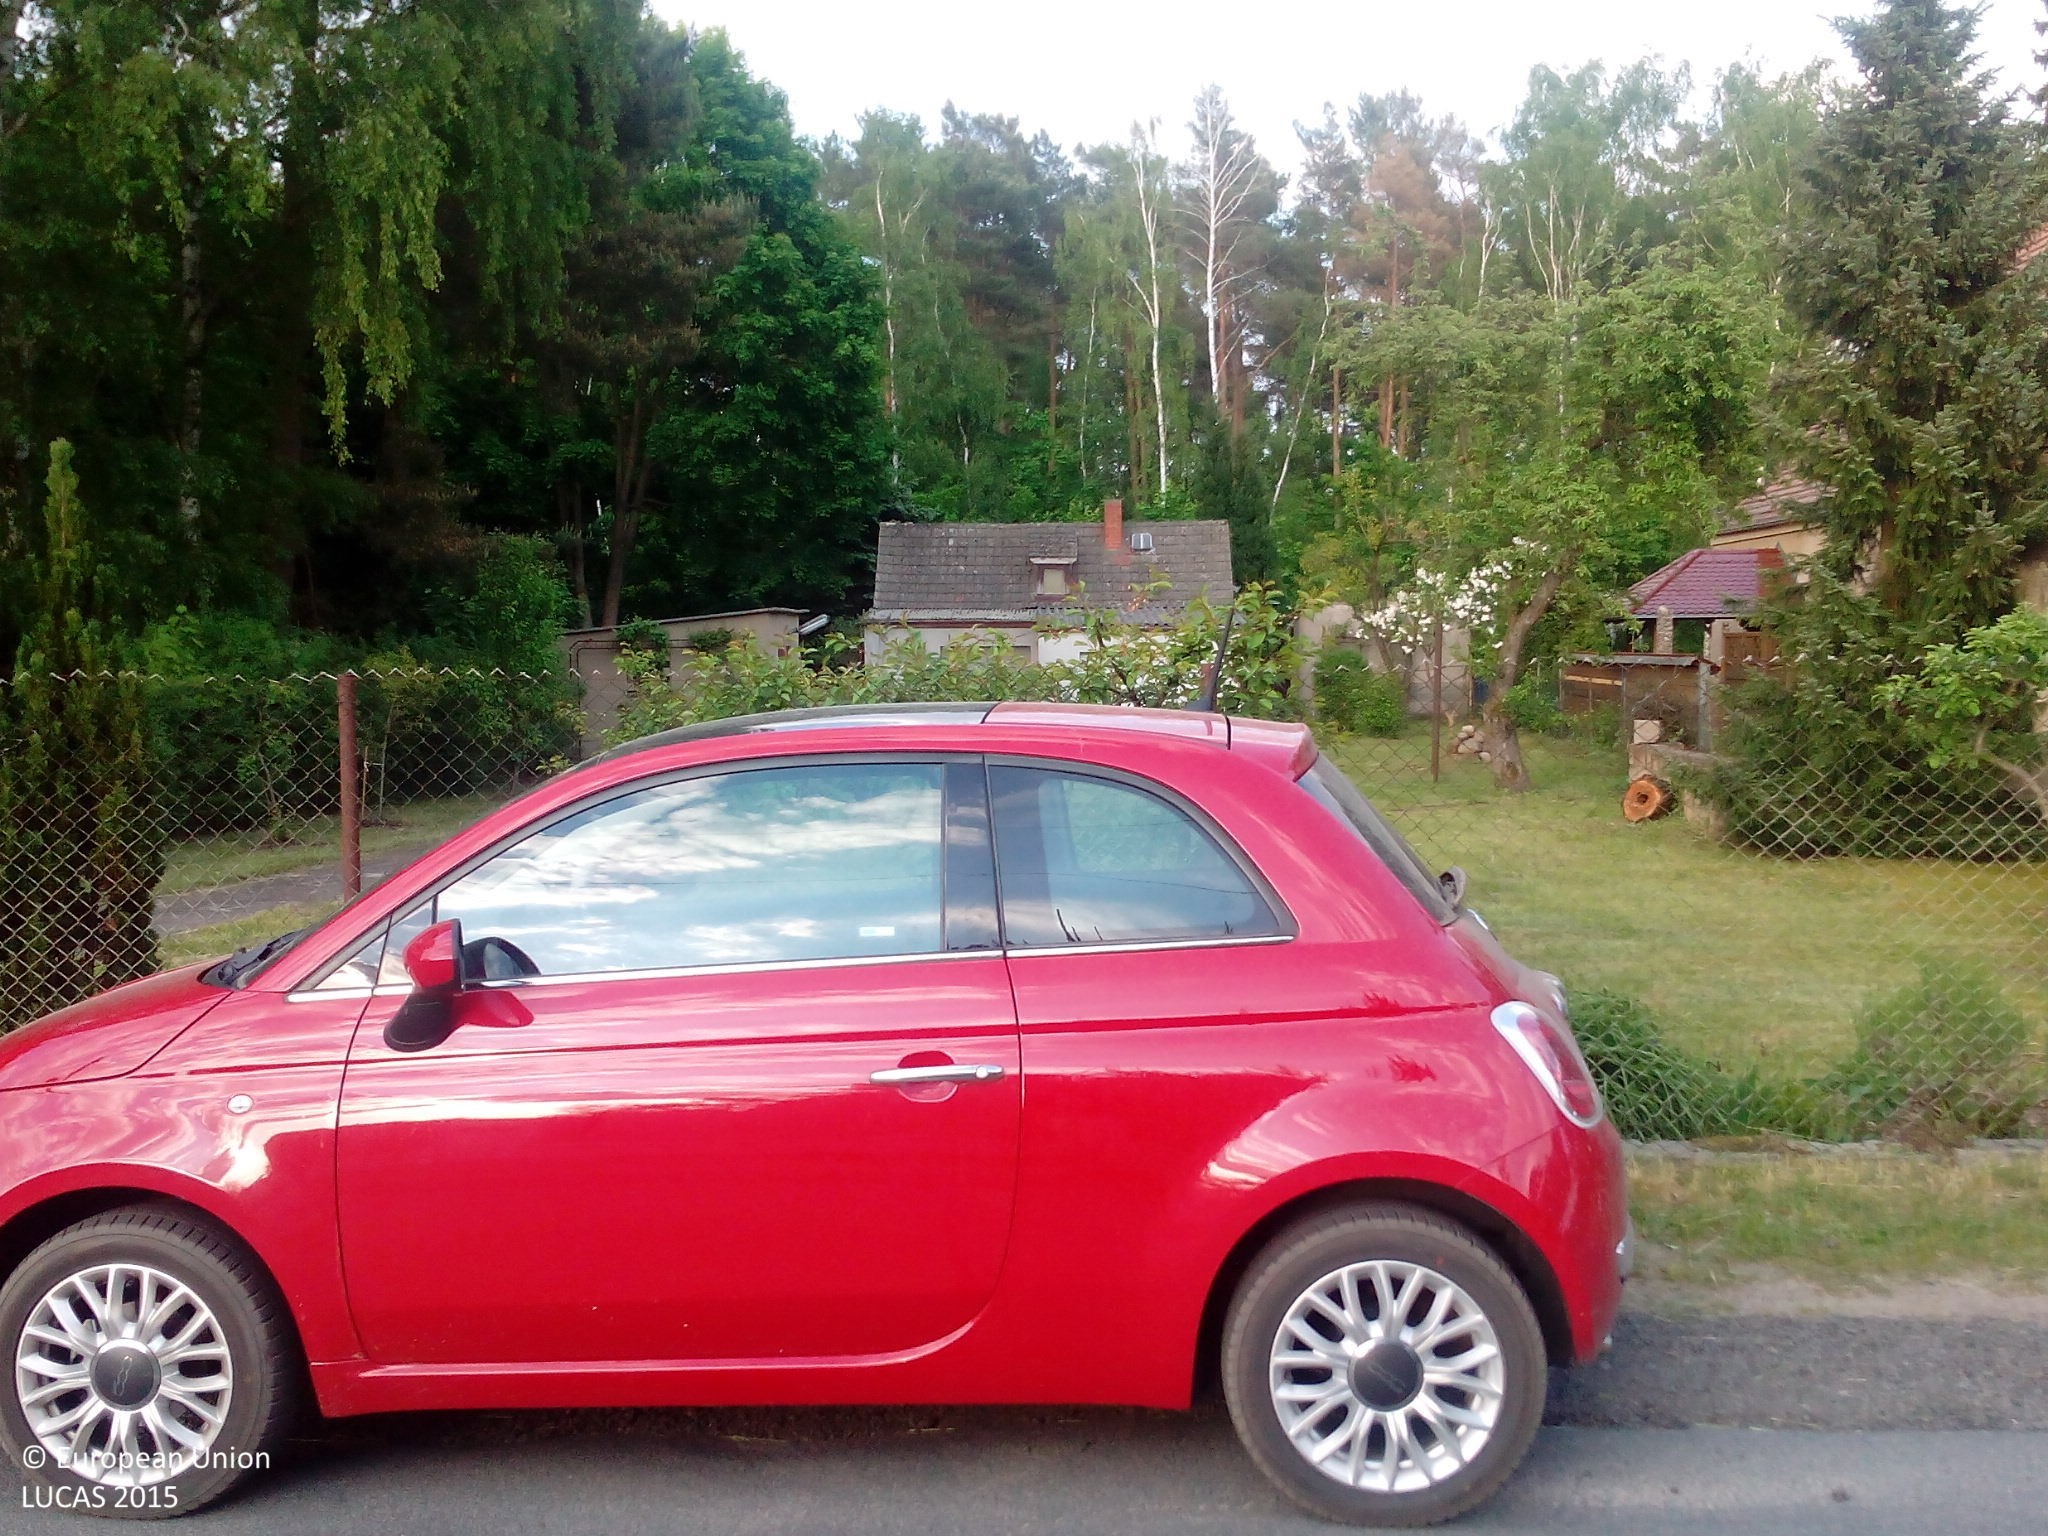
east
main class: Woodland
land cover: Pine dominated mixed woodland
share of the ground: 25 - 50 %
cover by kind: coniferous forest trees 25 %, broadleaved forest trees 25 %, consolidated bare surface 25 %, herbaceous plants 15 %, shrubs 10 %
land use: Residential
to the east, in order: Pine dominated mixed woodland; Artificial constructions in urban areas; Pine dominated mixed woodland; Spontaneously vegetated surfaces; Broadleaved woodland; Pine dominated mixed woodland; Electric lines; Pine dominated mixed woodland
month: May
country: DE
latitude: 52.1022
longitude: 13.1388
